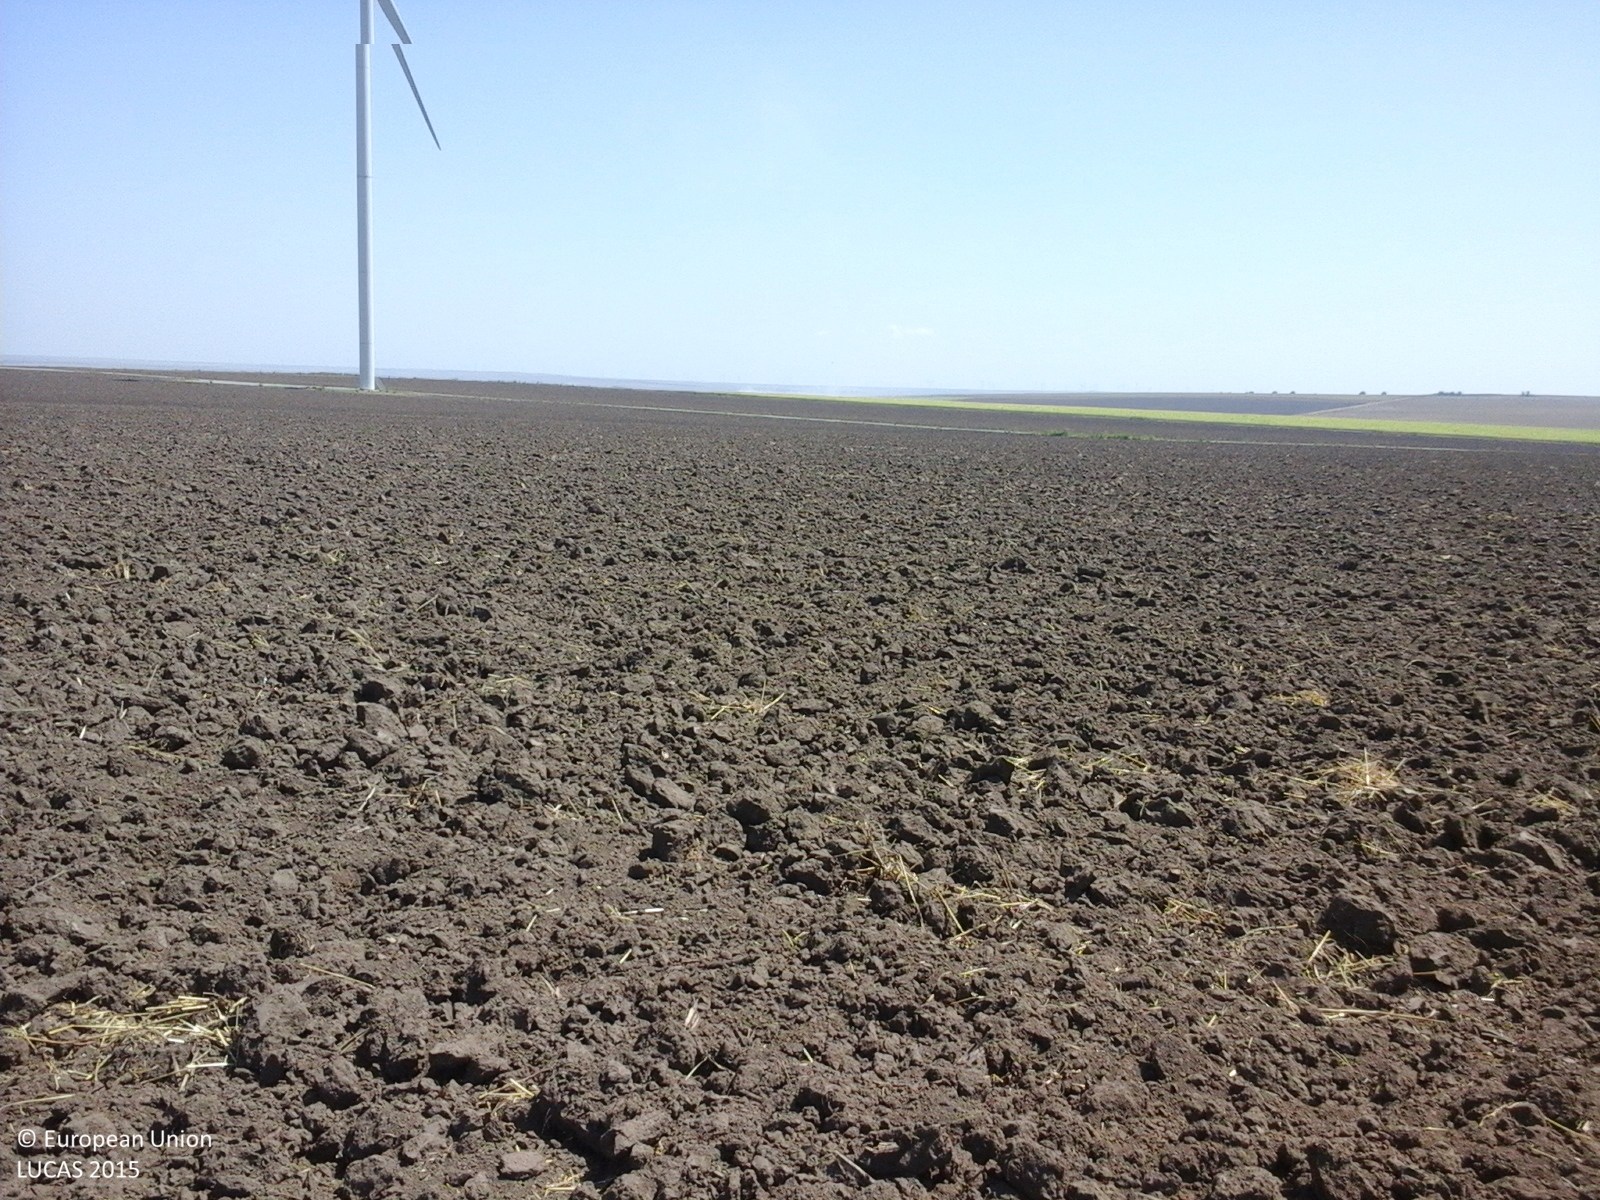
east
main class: Cropland
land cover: Barley
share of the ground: < 10 %
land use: Agriculture (excluding fallow land and kitchen gardens)
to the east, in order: Barley
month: August
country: RO
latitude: 44.5941
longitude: 28.2697
